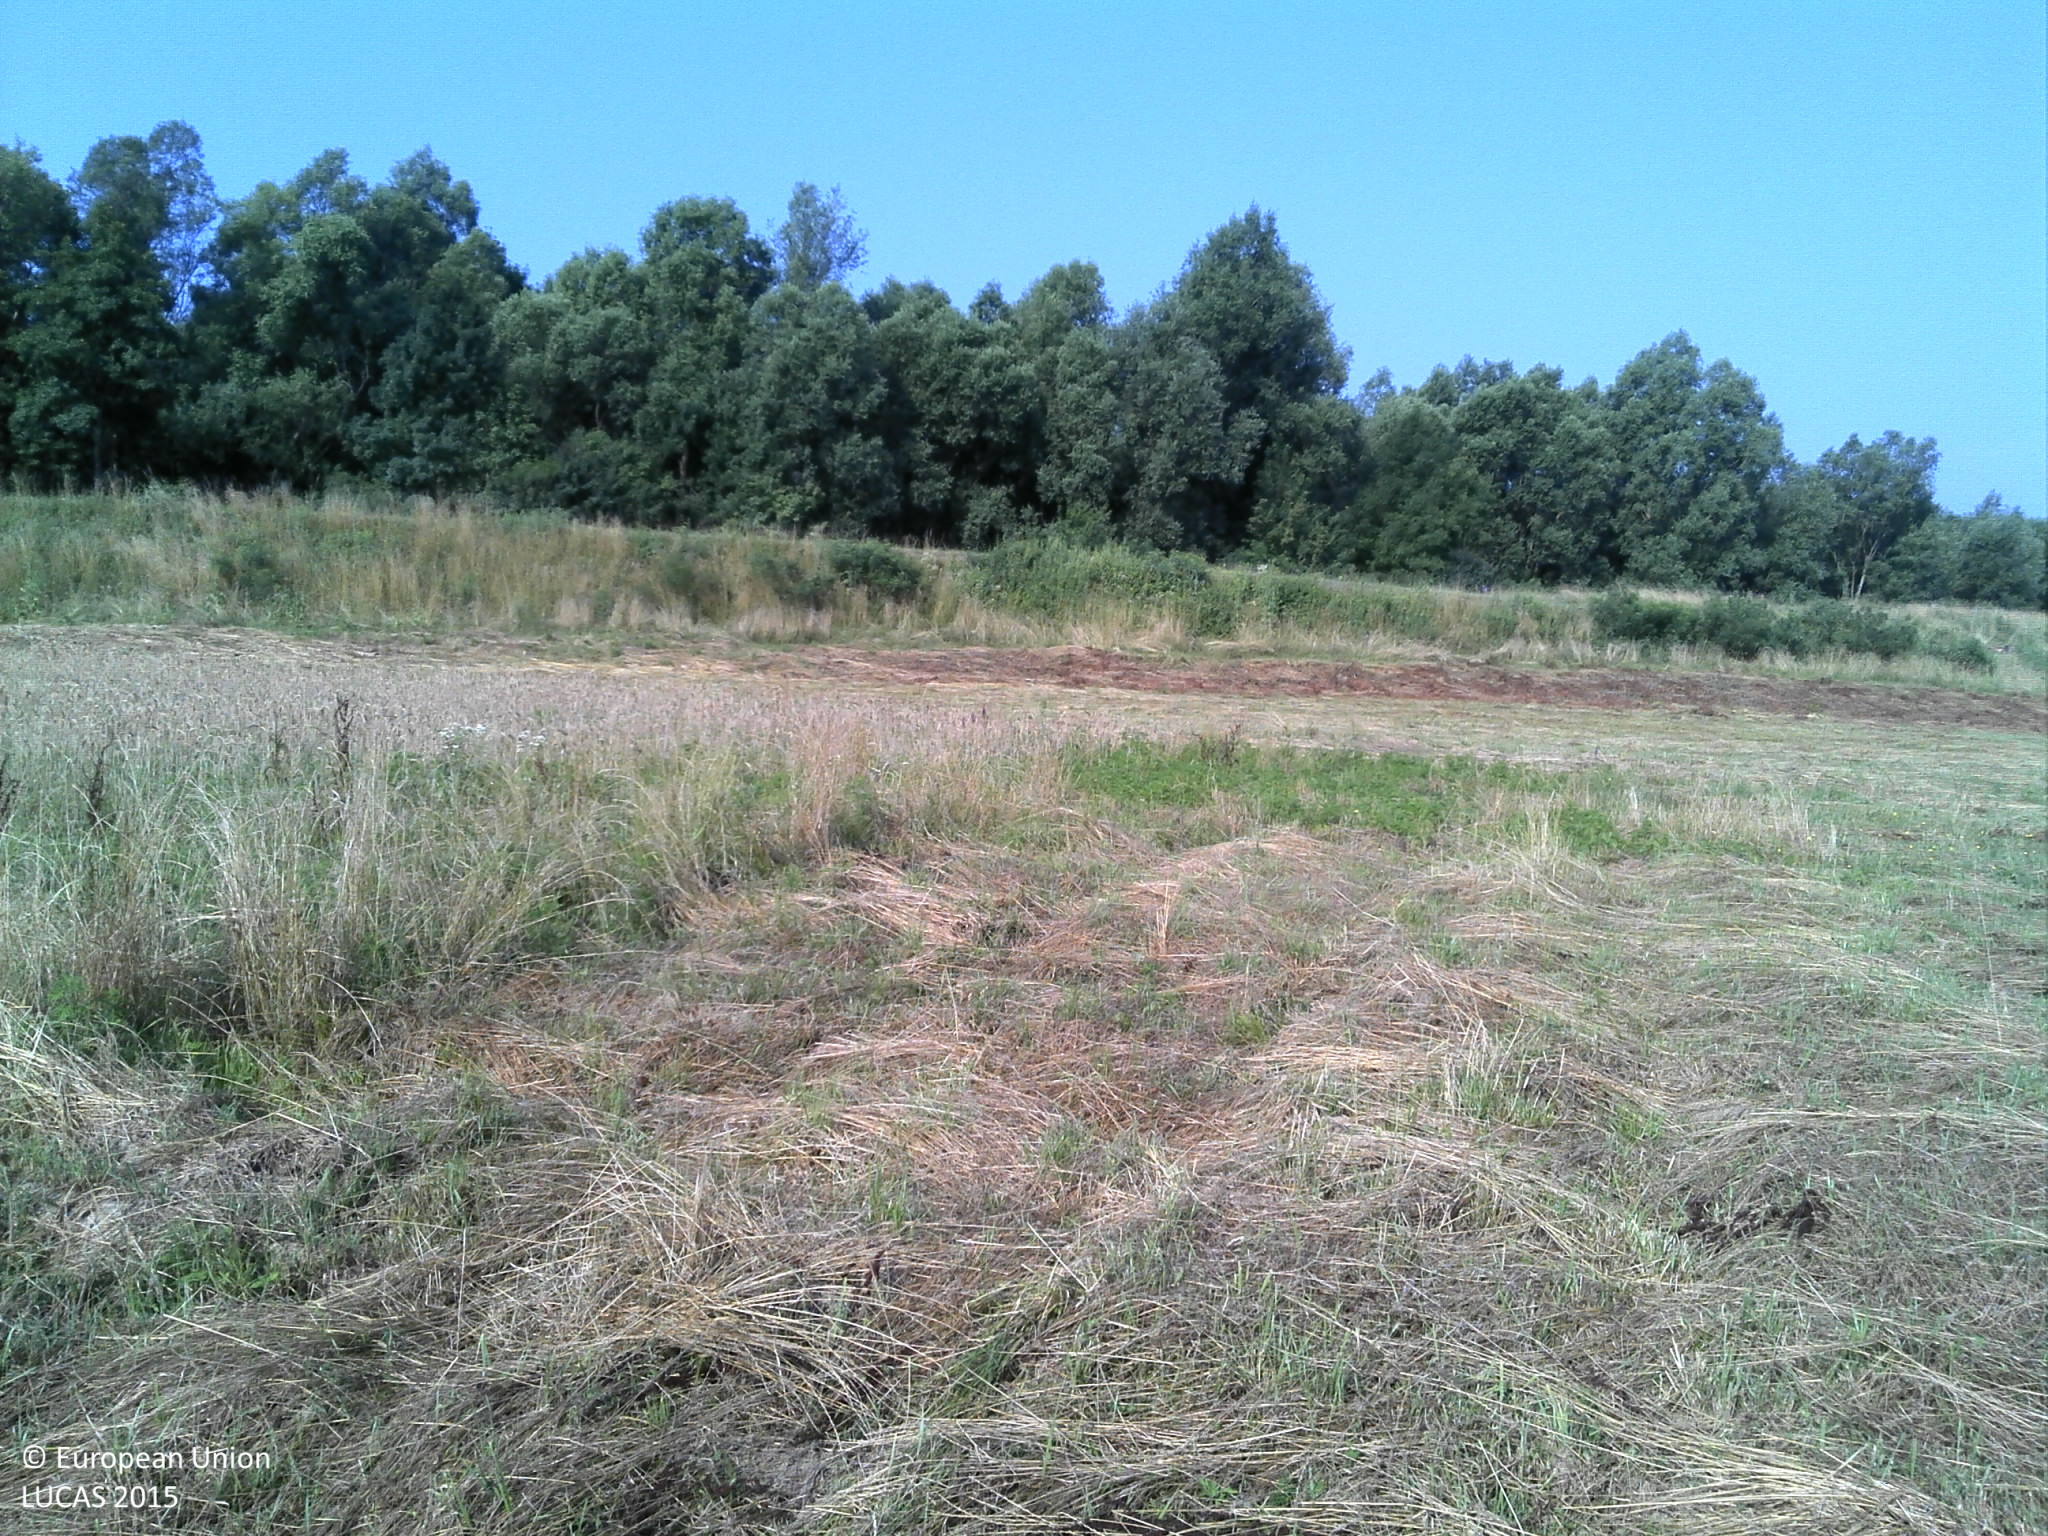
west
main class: Cropland
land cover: Temporary grasslands
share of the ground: > 75 %
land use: Agriculture (excluding fallow land and kitchen gardens)
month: July
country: HR
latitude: 45.7517
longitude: 16.5681
